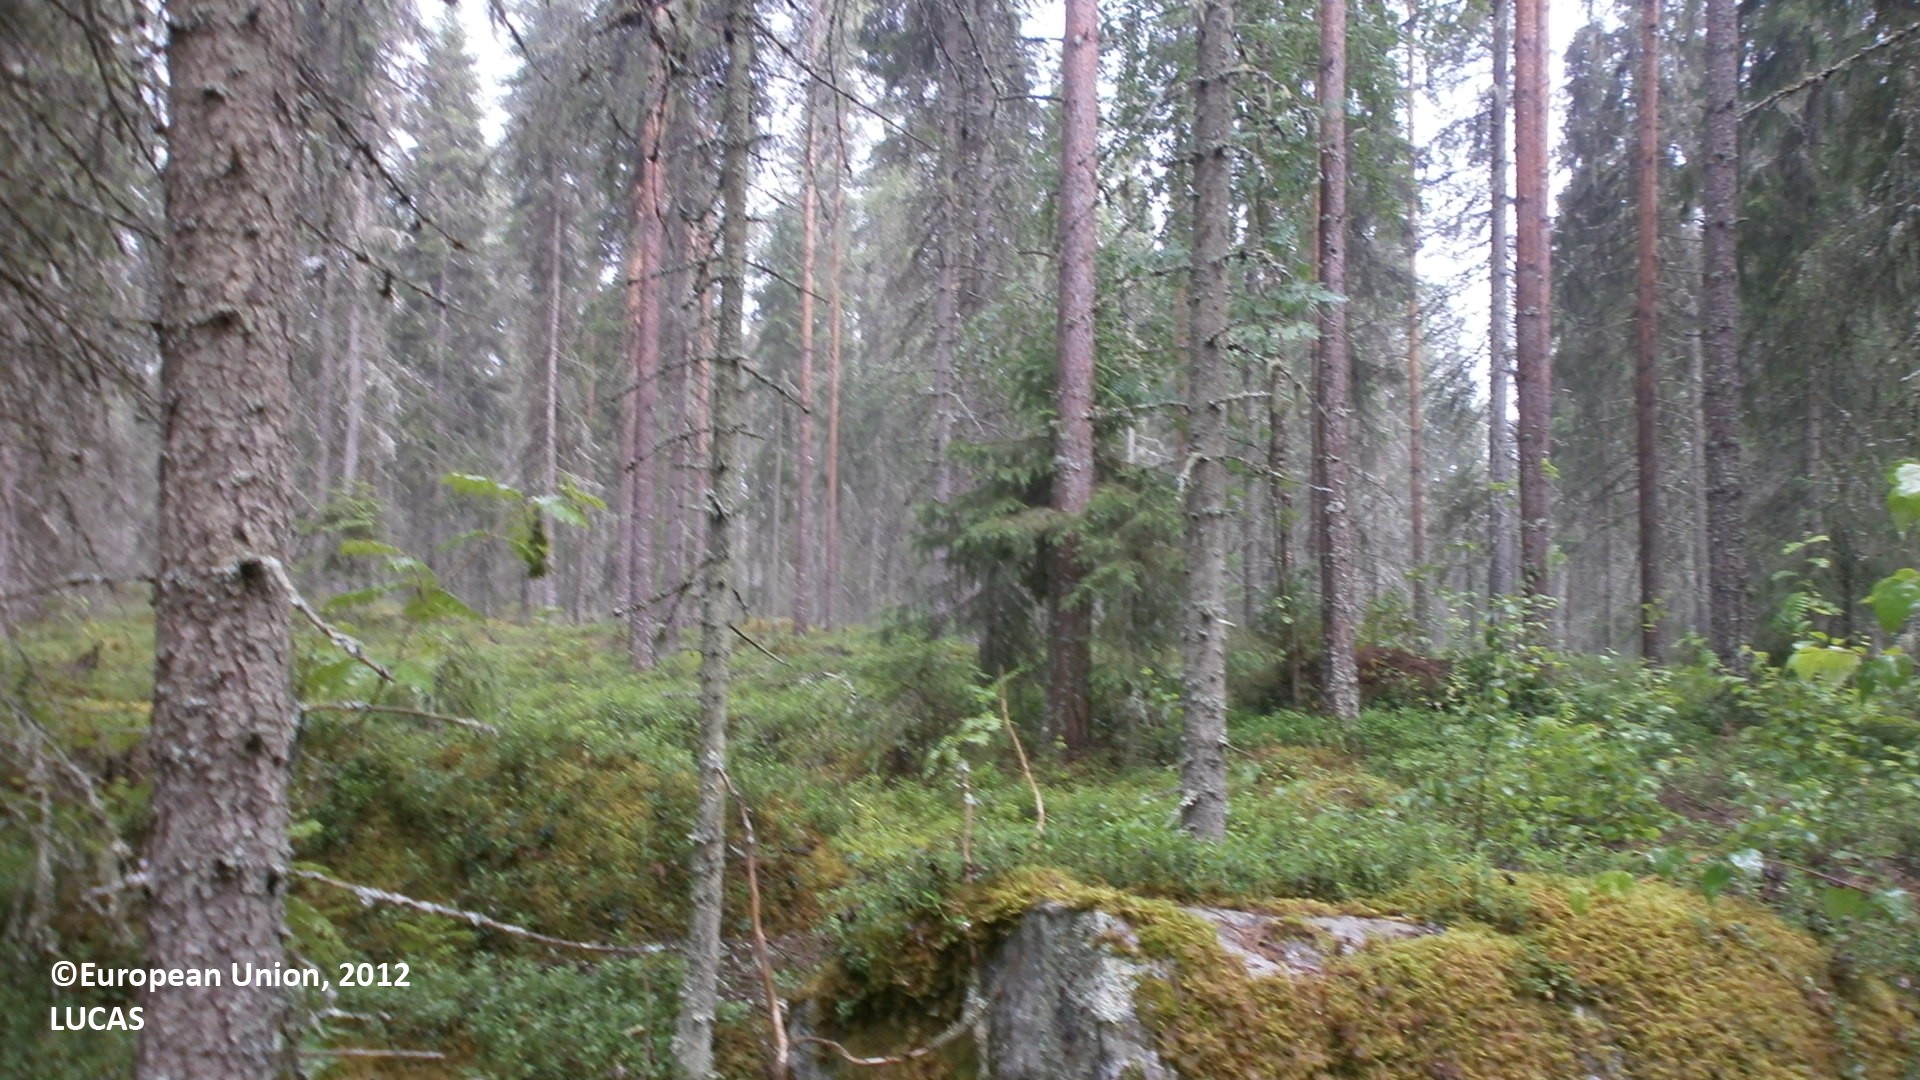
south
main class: Woodland
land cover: Spruce dominated coniferous woodland
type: boreal forest
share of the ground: 50 - 75 %
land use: Forestry
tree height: > 5 m
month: July
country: FI
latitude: 64.0874
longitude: 23.7819
